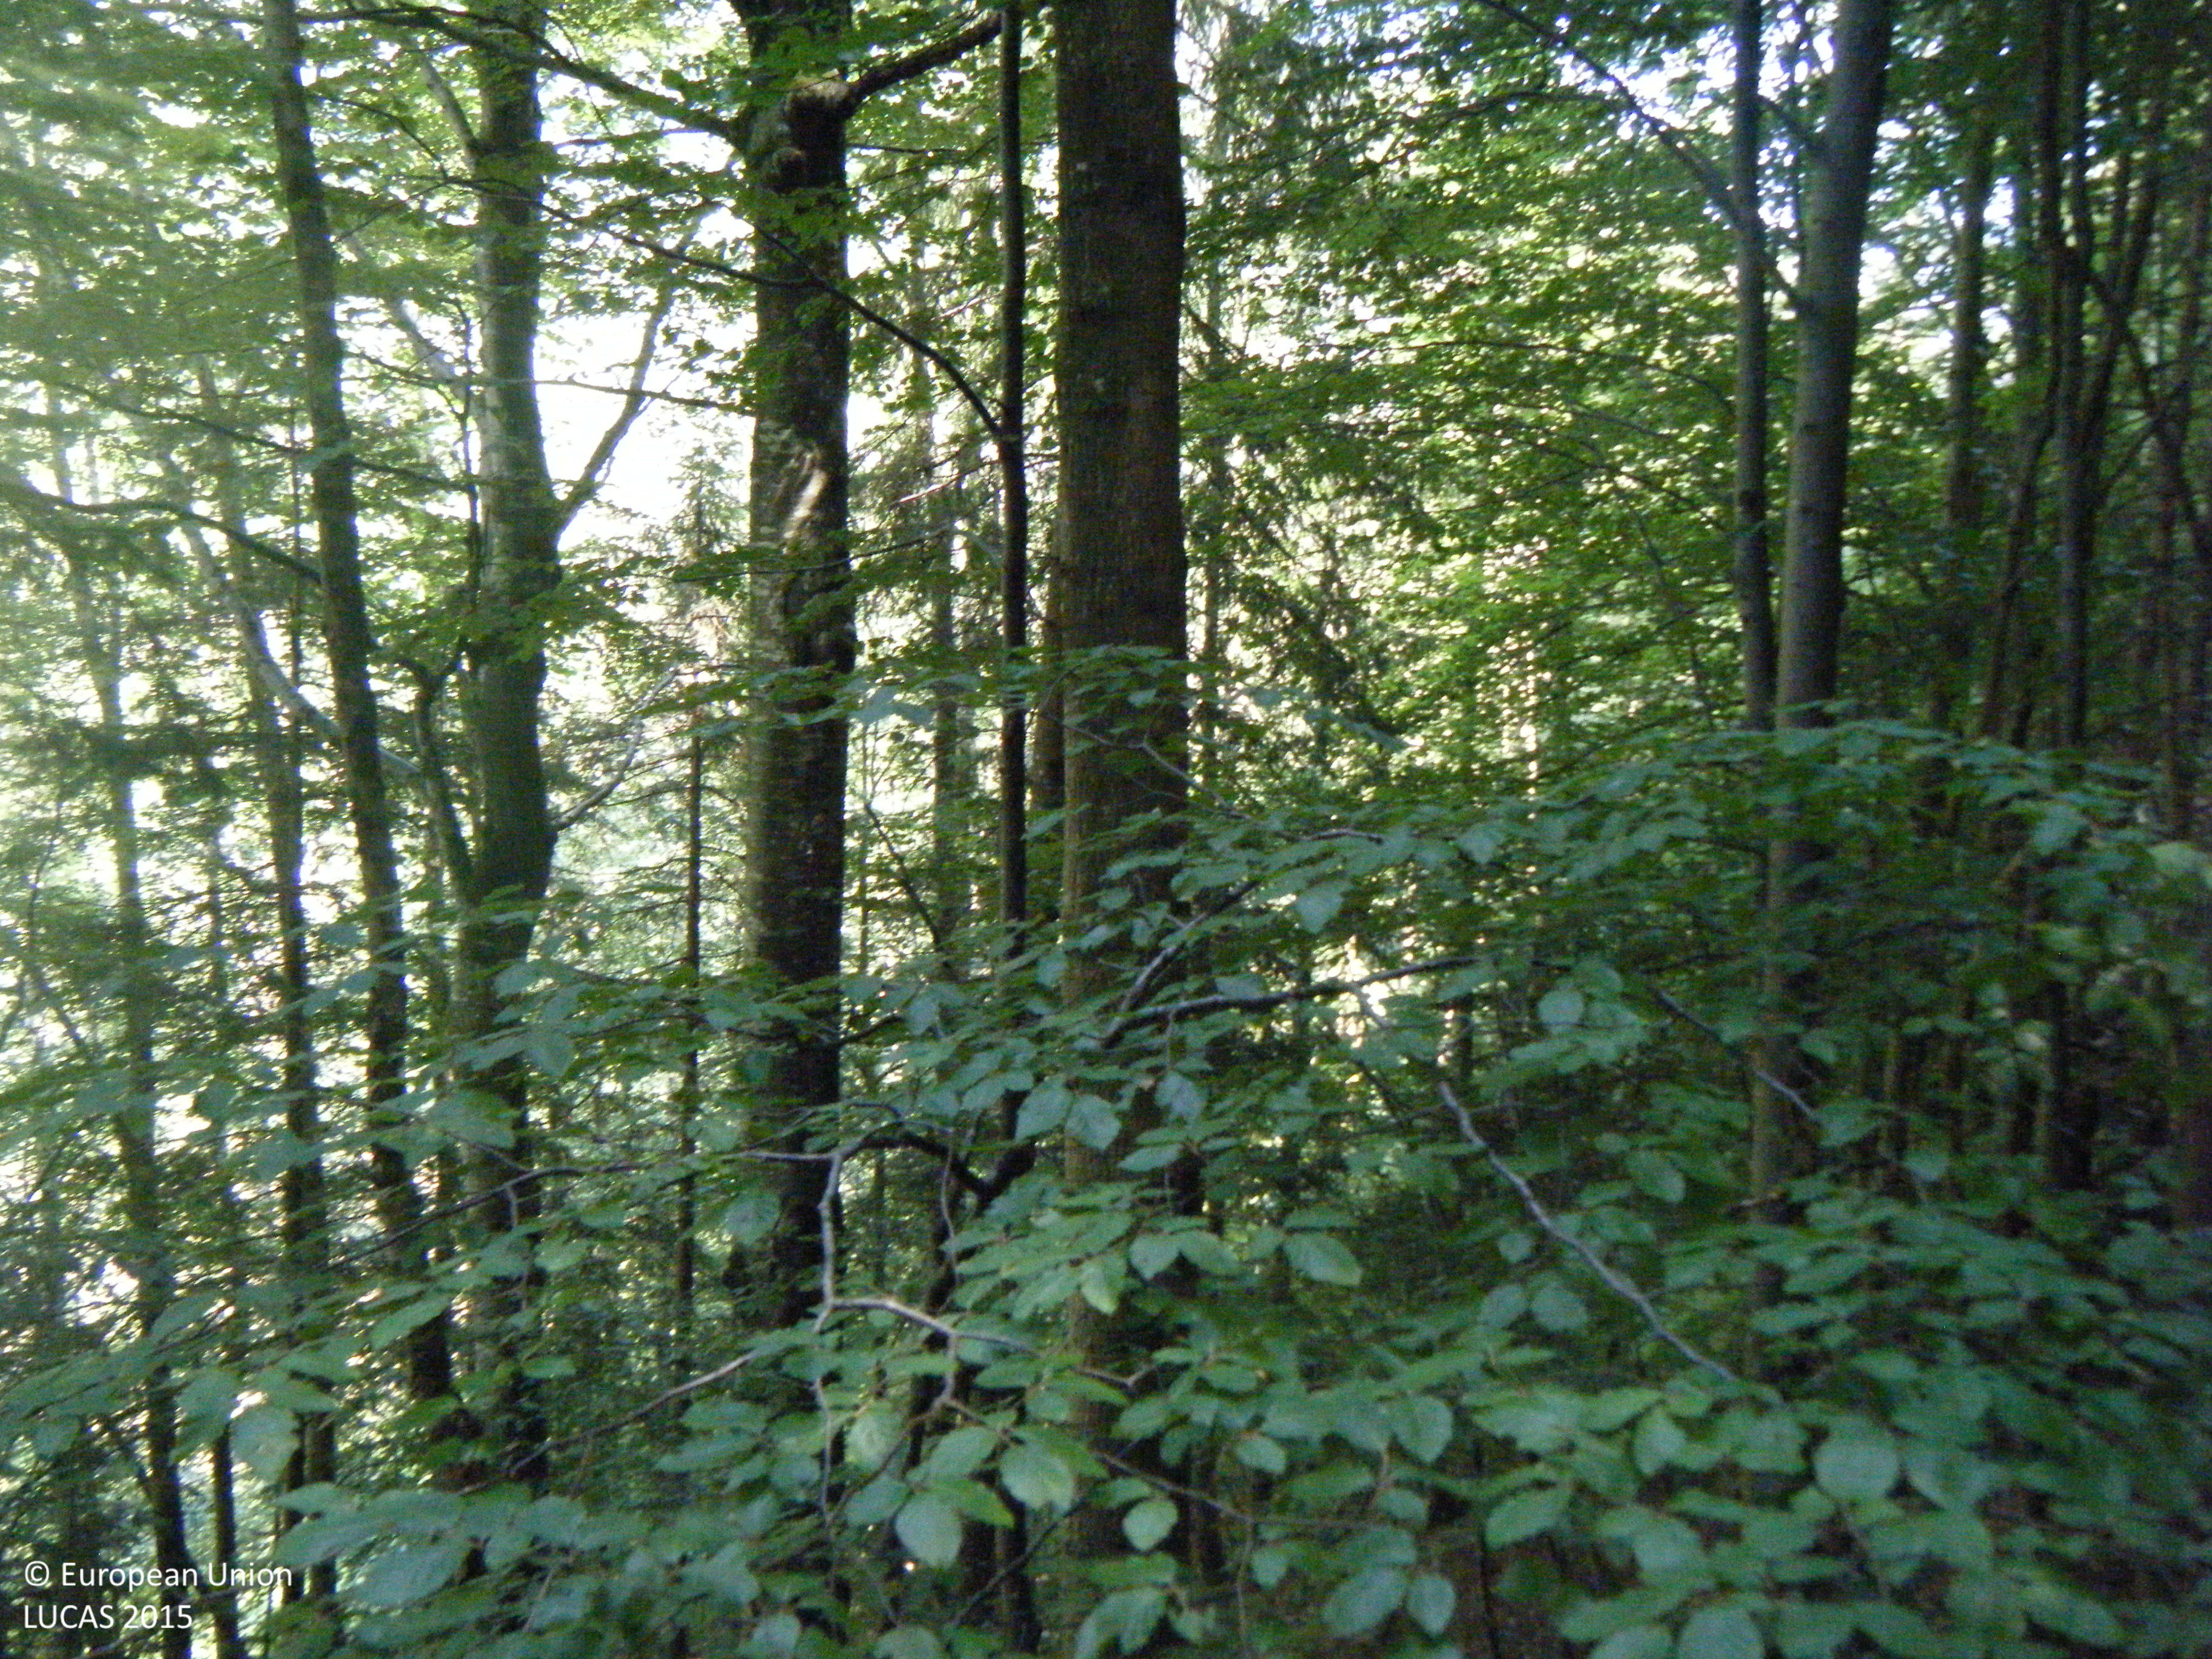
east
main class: Woodland
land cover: Spruce dominated mixed woodland
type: mountainous beech forest
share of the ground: > 75 %
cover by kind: broadleaved forest trees 65 %, coniferous forest trees 25 %, consolidated bare surface 10 %
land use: Forestry
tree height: > 5 m
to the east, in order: Spruce dominated mixed woodland; Broadleaved woodland; Grassland without tree/shrub cover; Ditches and canals; Grassland without tree/shrub cover; Tracks; Spruce dominated mixed woodland; Grassland without tree/shrub cover; Spruce dominated coniferous woodland; Grassland without tree/shrub cover; Broadleaved woodland; Ditches and canals; Grassland with sparse tree/shrub cover; Paved roads, cycling and walking lanes
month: July
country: AT
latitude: 47.7953
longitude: 13.3229
